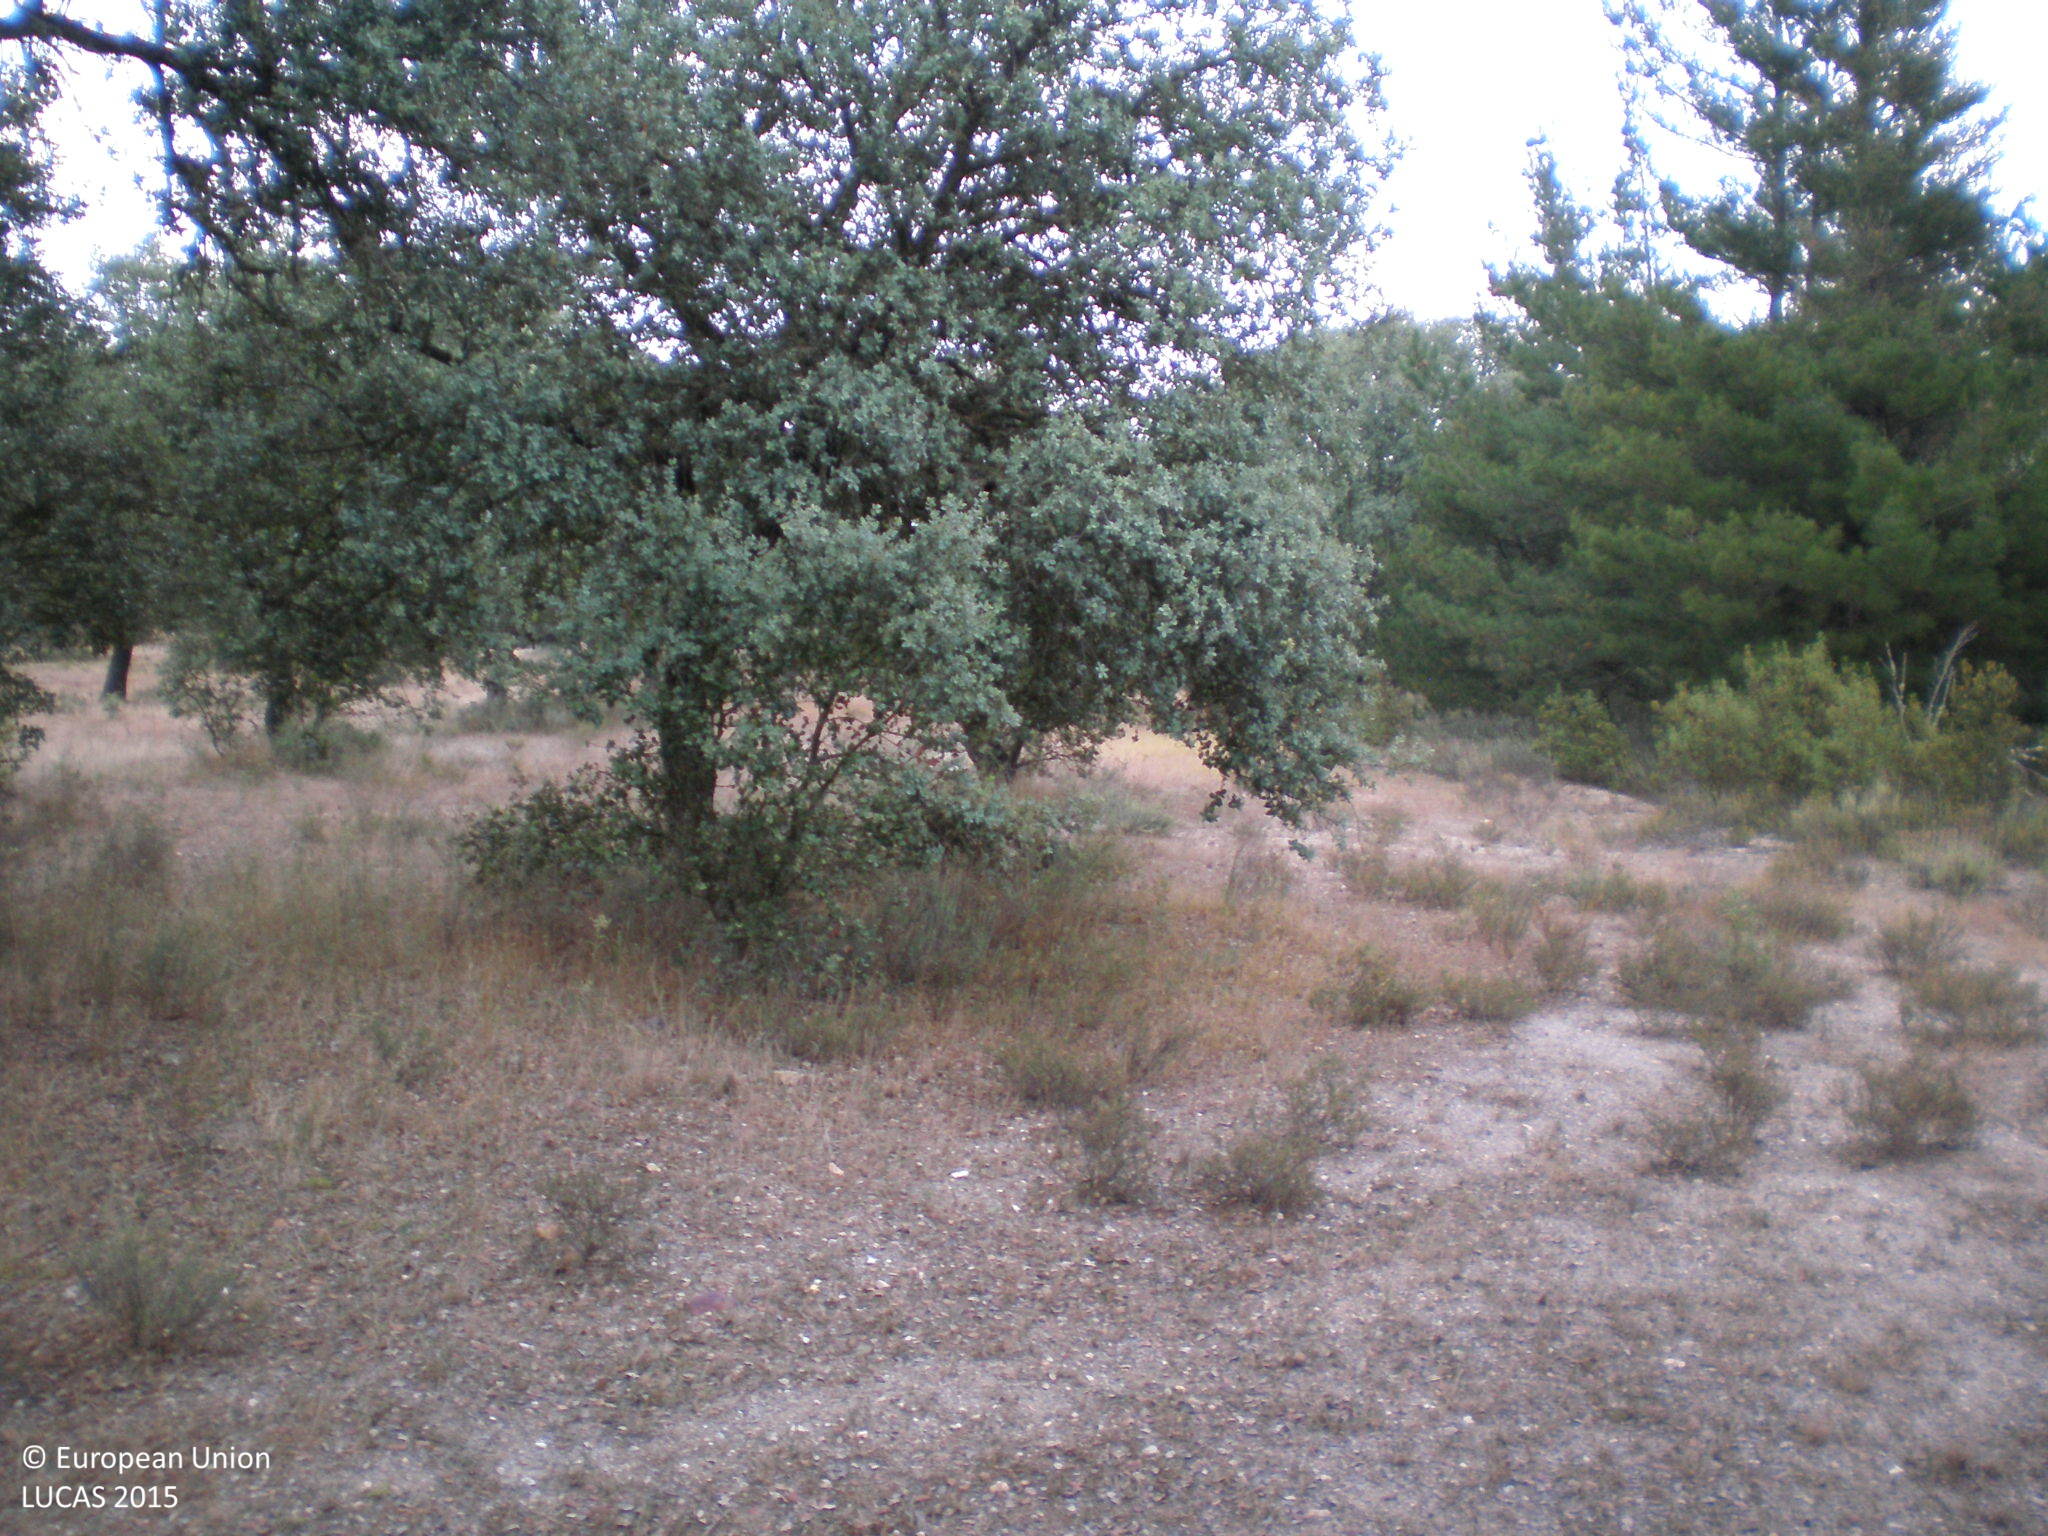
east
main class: Woodland
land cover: Broadleaved woodland
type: broadleaved evergreen forest
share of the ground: 50 - 75 %
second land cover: Grassland without tree/shrub cover
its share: 25 - 50 %
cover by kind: broadleaved forest trees 60 %, herbaceous plants 40 %
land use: Forestry
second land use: Agriculture (excluding fallow land and kitchen gardens)
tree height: > 5 m
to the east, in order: Broadleaved woodland; Grassland without tree/shrub cover; Pine dominated coniferous woodland
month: June
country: ES
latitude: 41.1301
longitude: -5.7941
